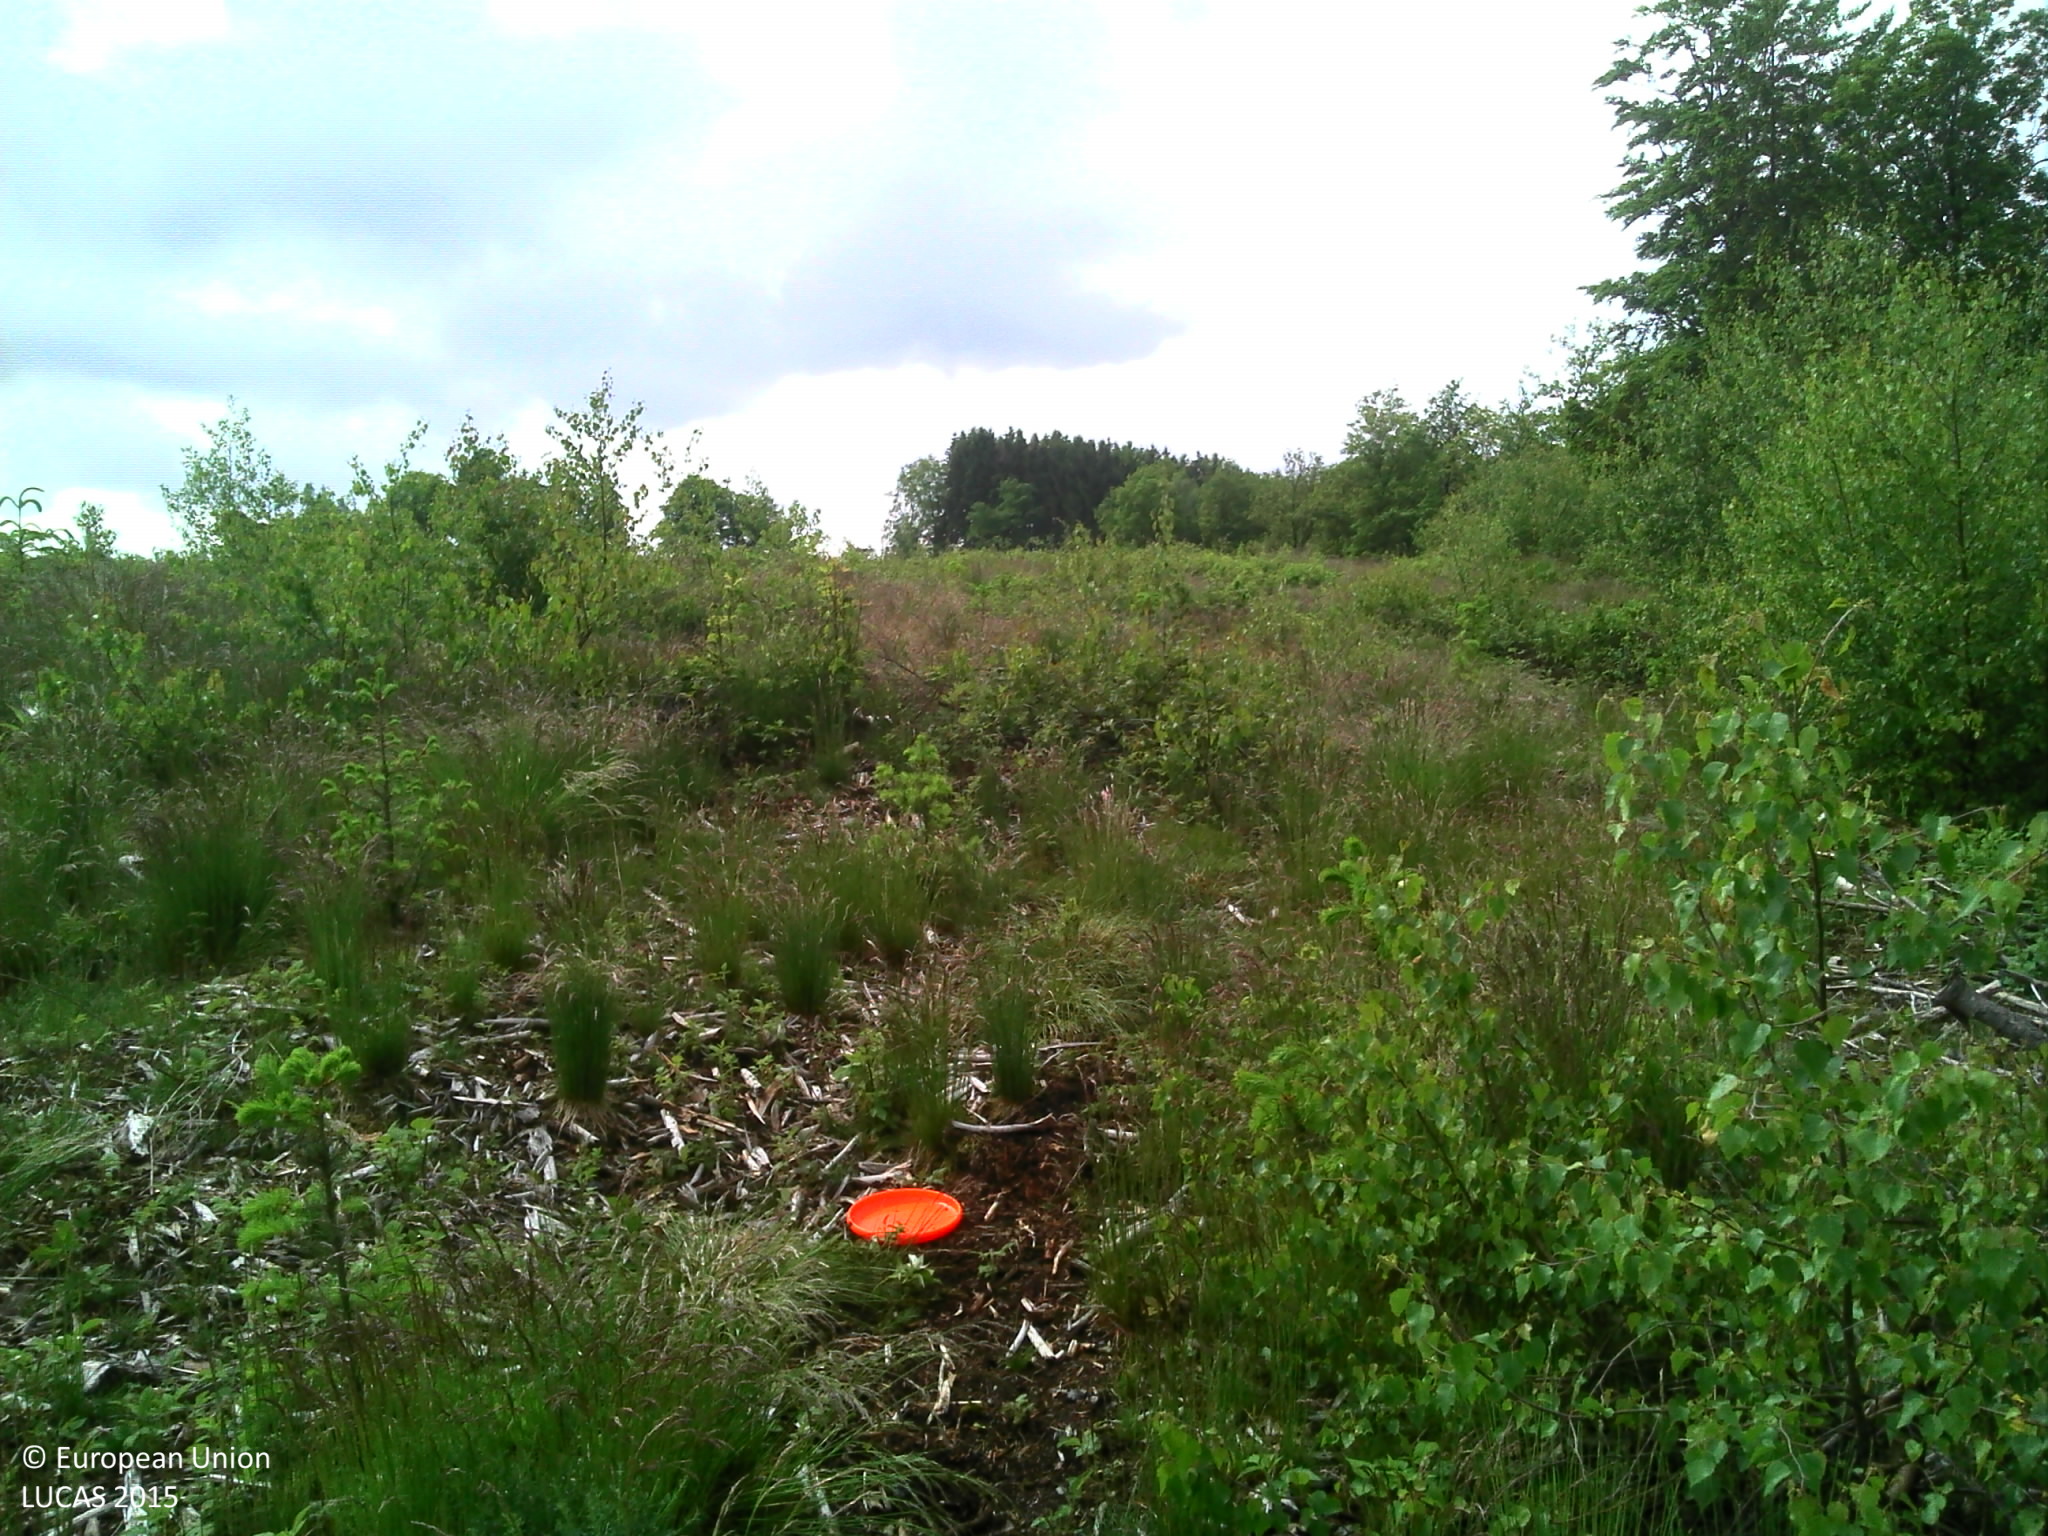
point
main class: Shrubland
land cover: Shrubland without tree cover
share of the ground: > 75 %
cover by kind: shrubs 60 %, herbaceous plants 40 %
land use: Forestry
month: June
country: BE
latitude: 50.2681
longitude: 5.7758
